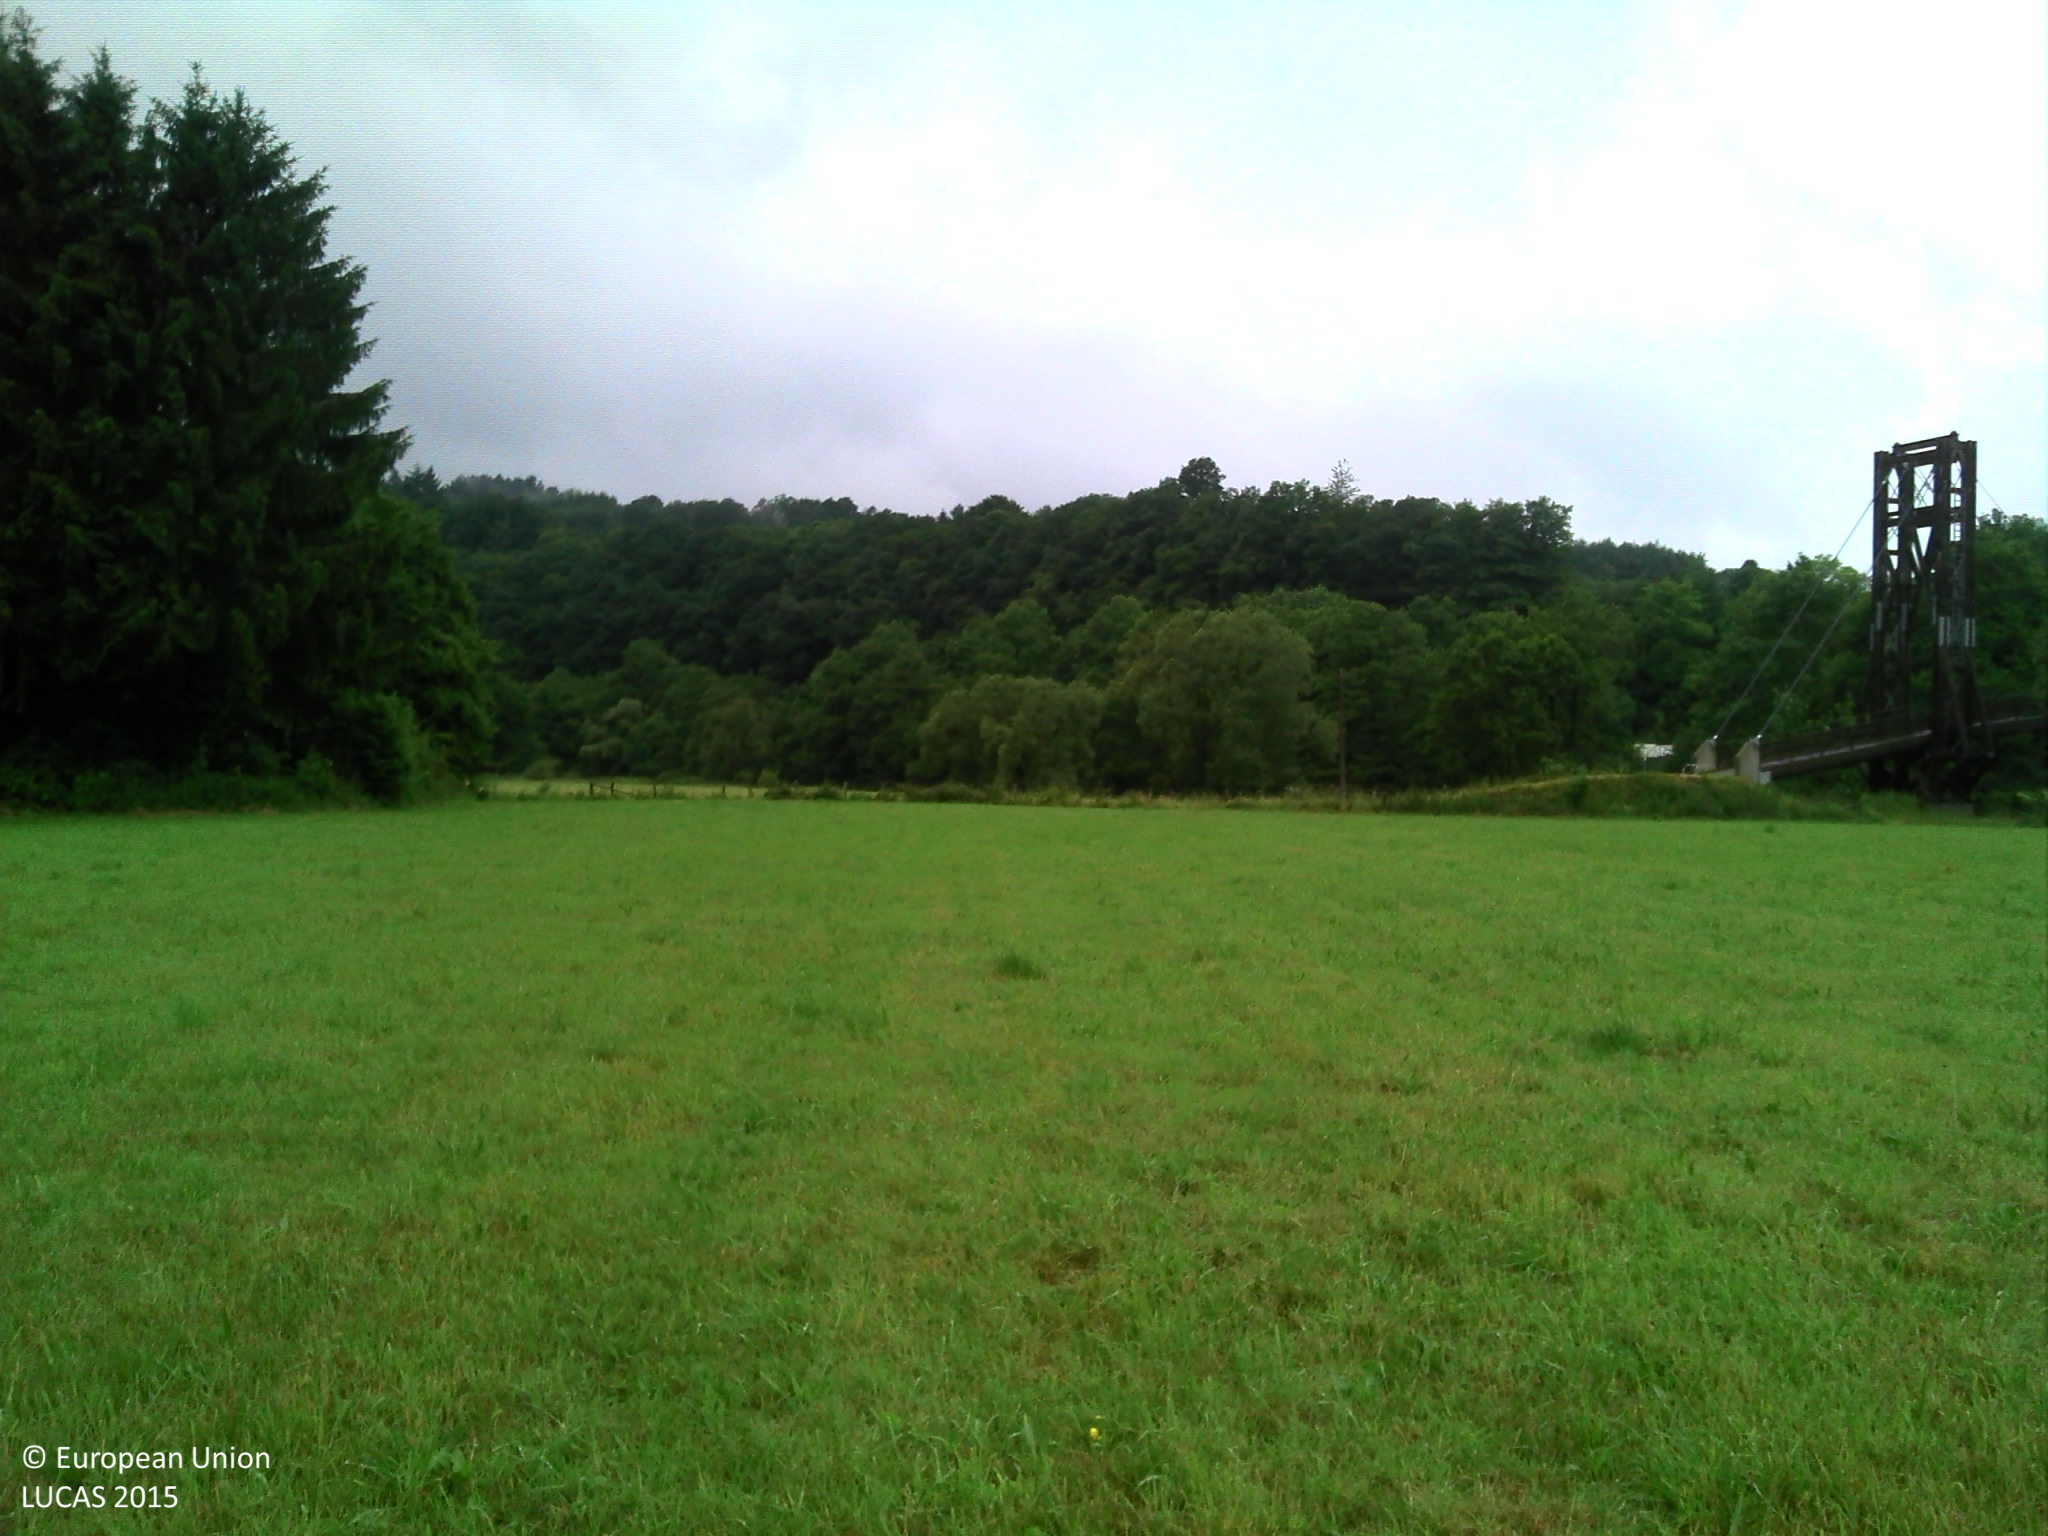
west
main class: Grassland
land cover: Grassland without tree/shrub cover
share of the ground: > 75 %
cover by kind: herbaceous plants 100 %
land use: Agriculture (excluding fallow land and kitchen gardens)
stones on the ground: < 10 %
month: June
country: BE
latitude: 50.2226
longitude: 5.5272
